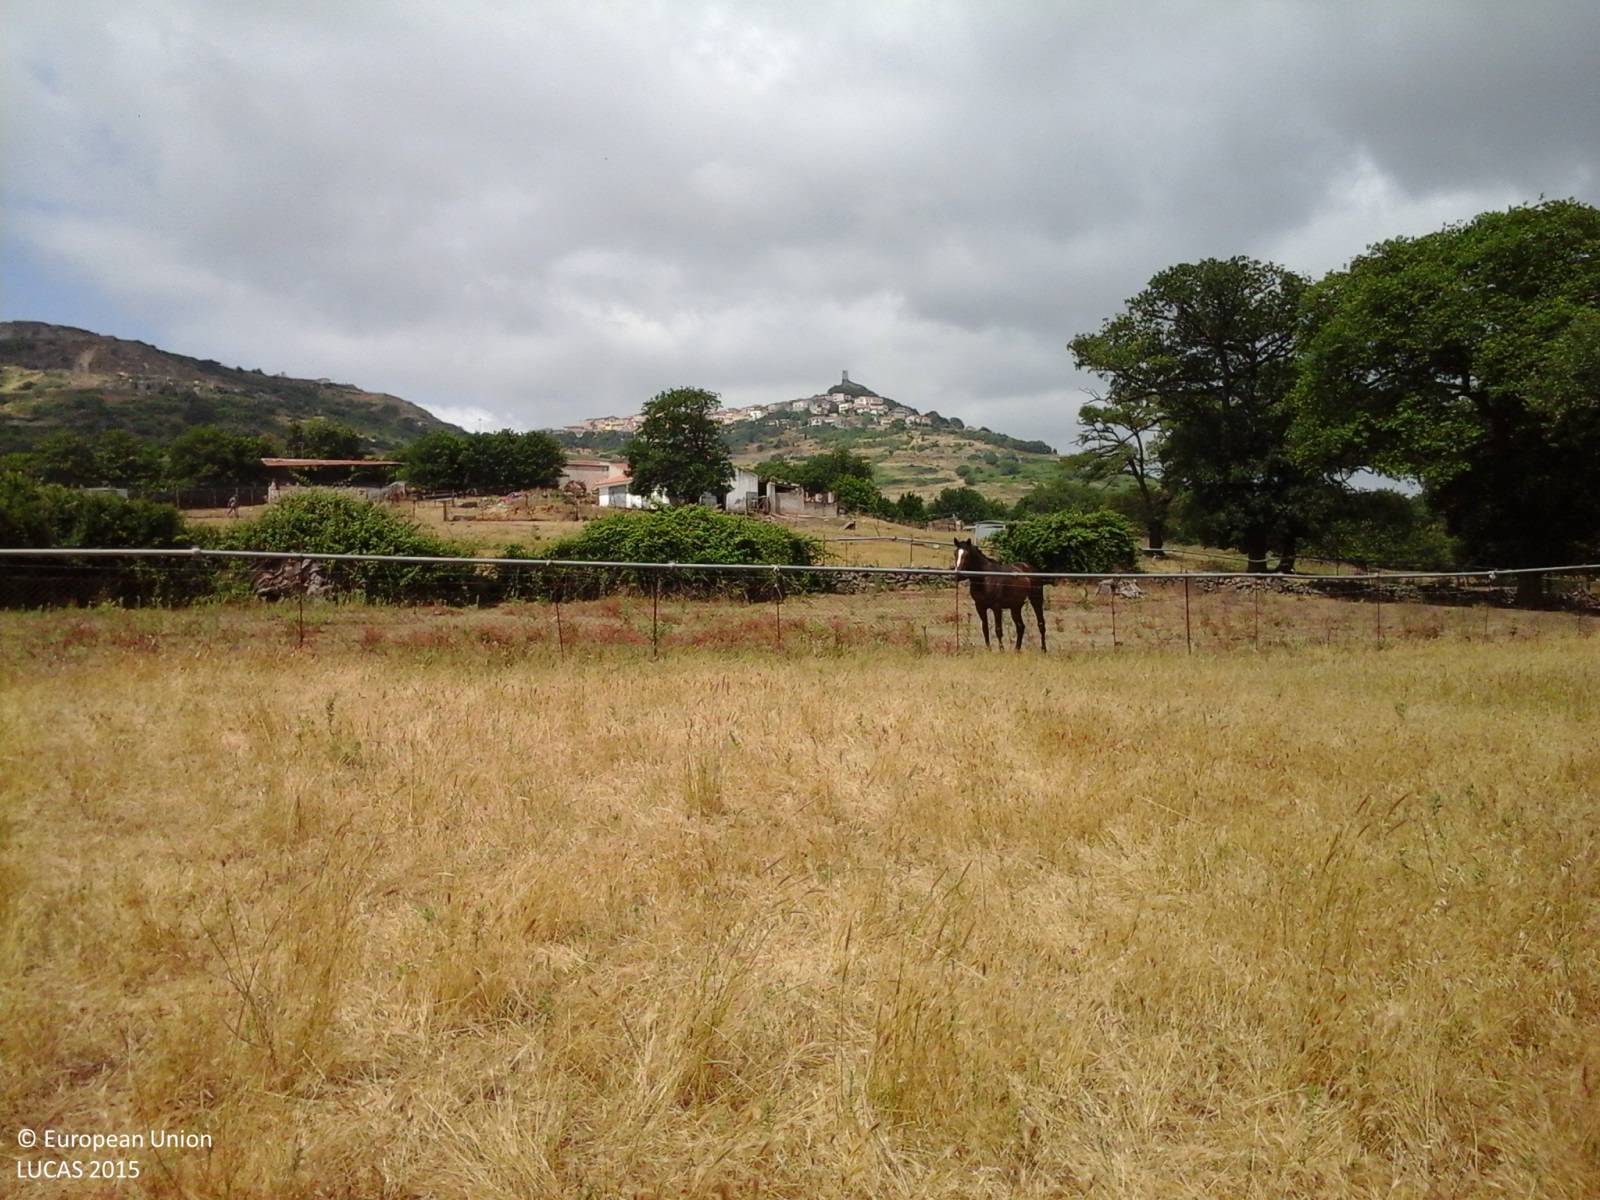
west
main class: Grassland
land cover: Grassland without tree/shrub cover
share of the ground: 50 - 75 %
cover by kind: herbaceous plants 100 %
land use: Agriculture (excluding fallow land and kitchen gardens)
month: June
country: IT
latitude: 40.7473
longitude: 8.6917
